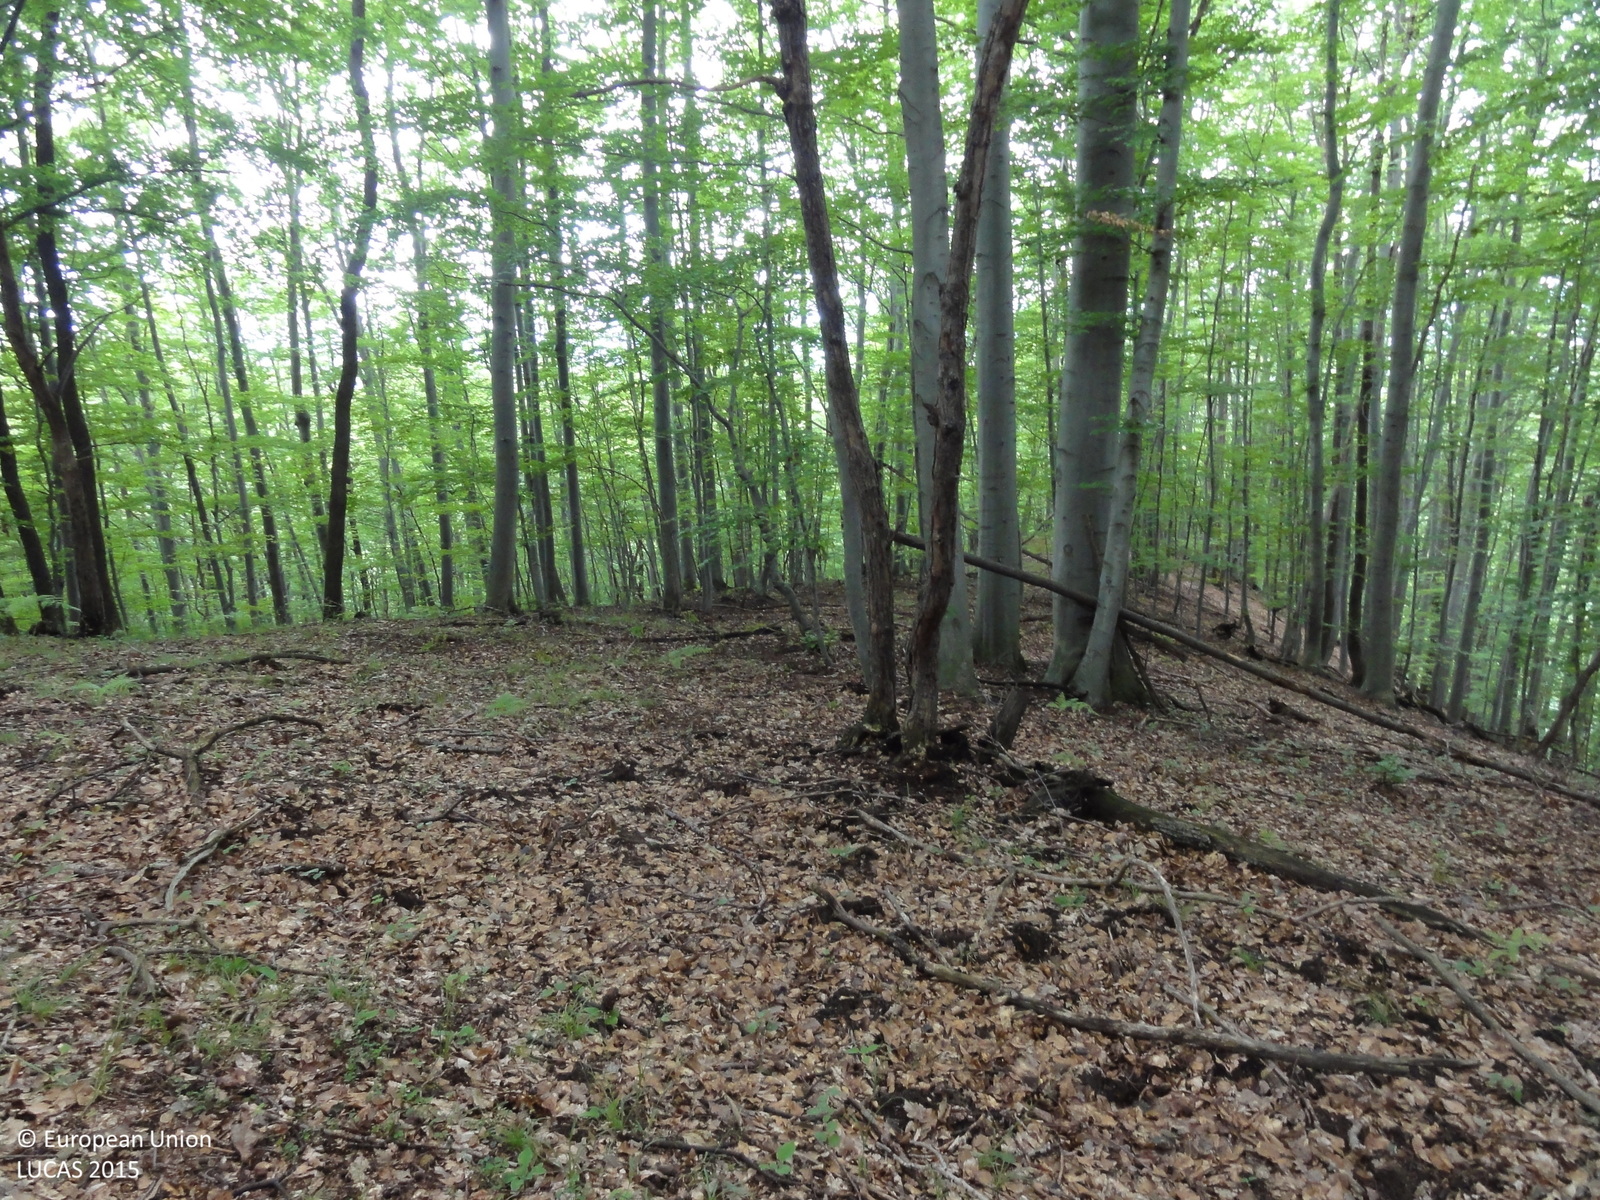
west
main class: Woodland
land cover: Broadleaved woodland
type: beech forest
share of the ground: > 75 %
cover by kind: broadleaved forest trees 100 %
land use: Forestry
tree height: > 5 m
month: June
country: SI
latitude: 46.3256
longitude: 15.7007
